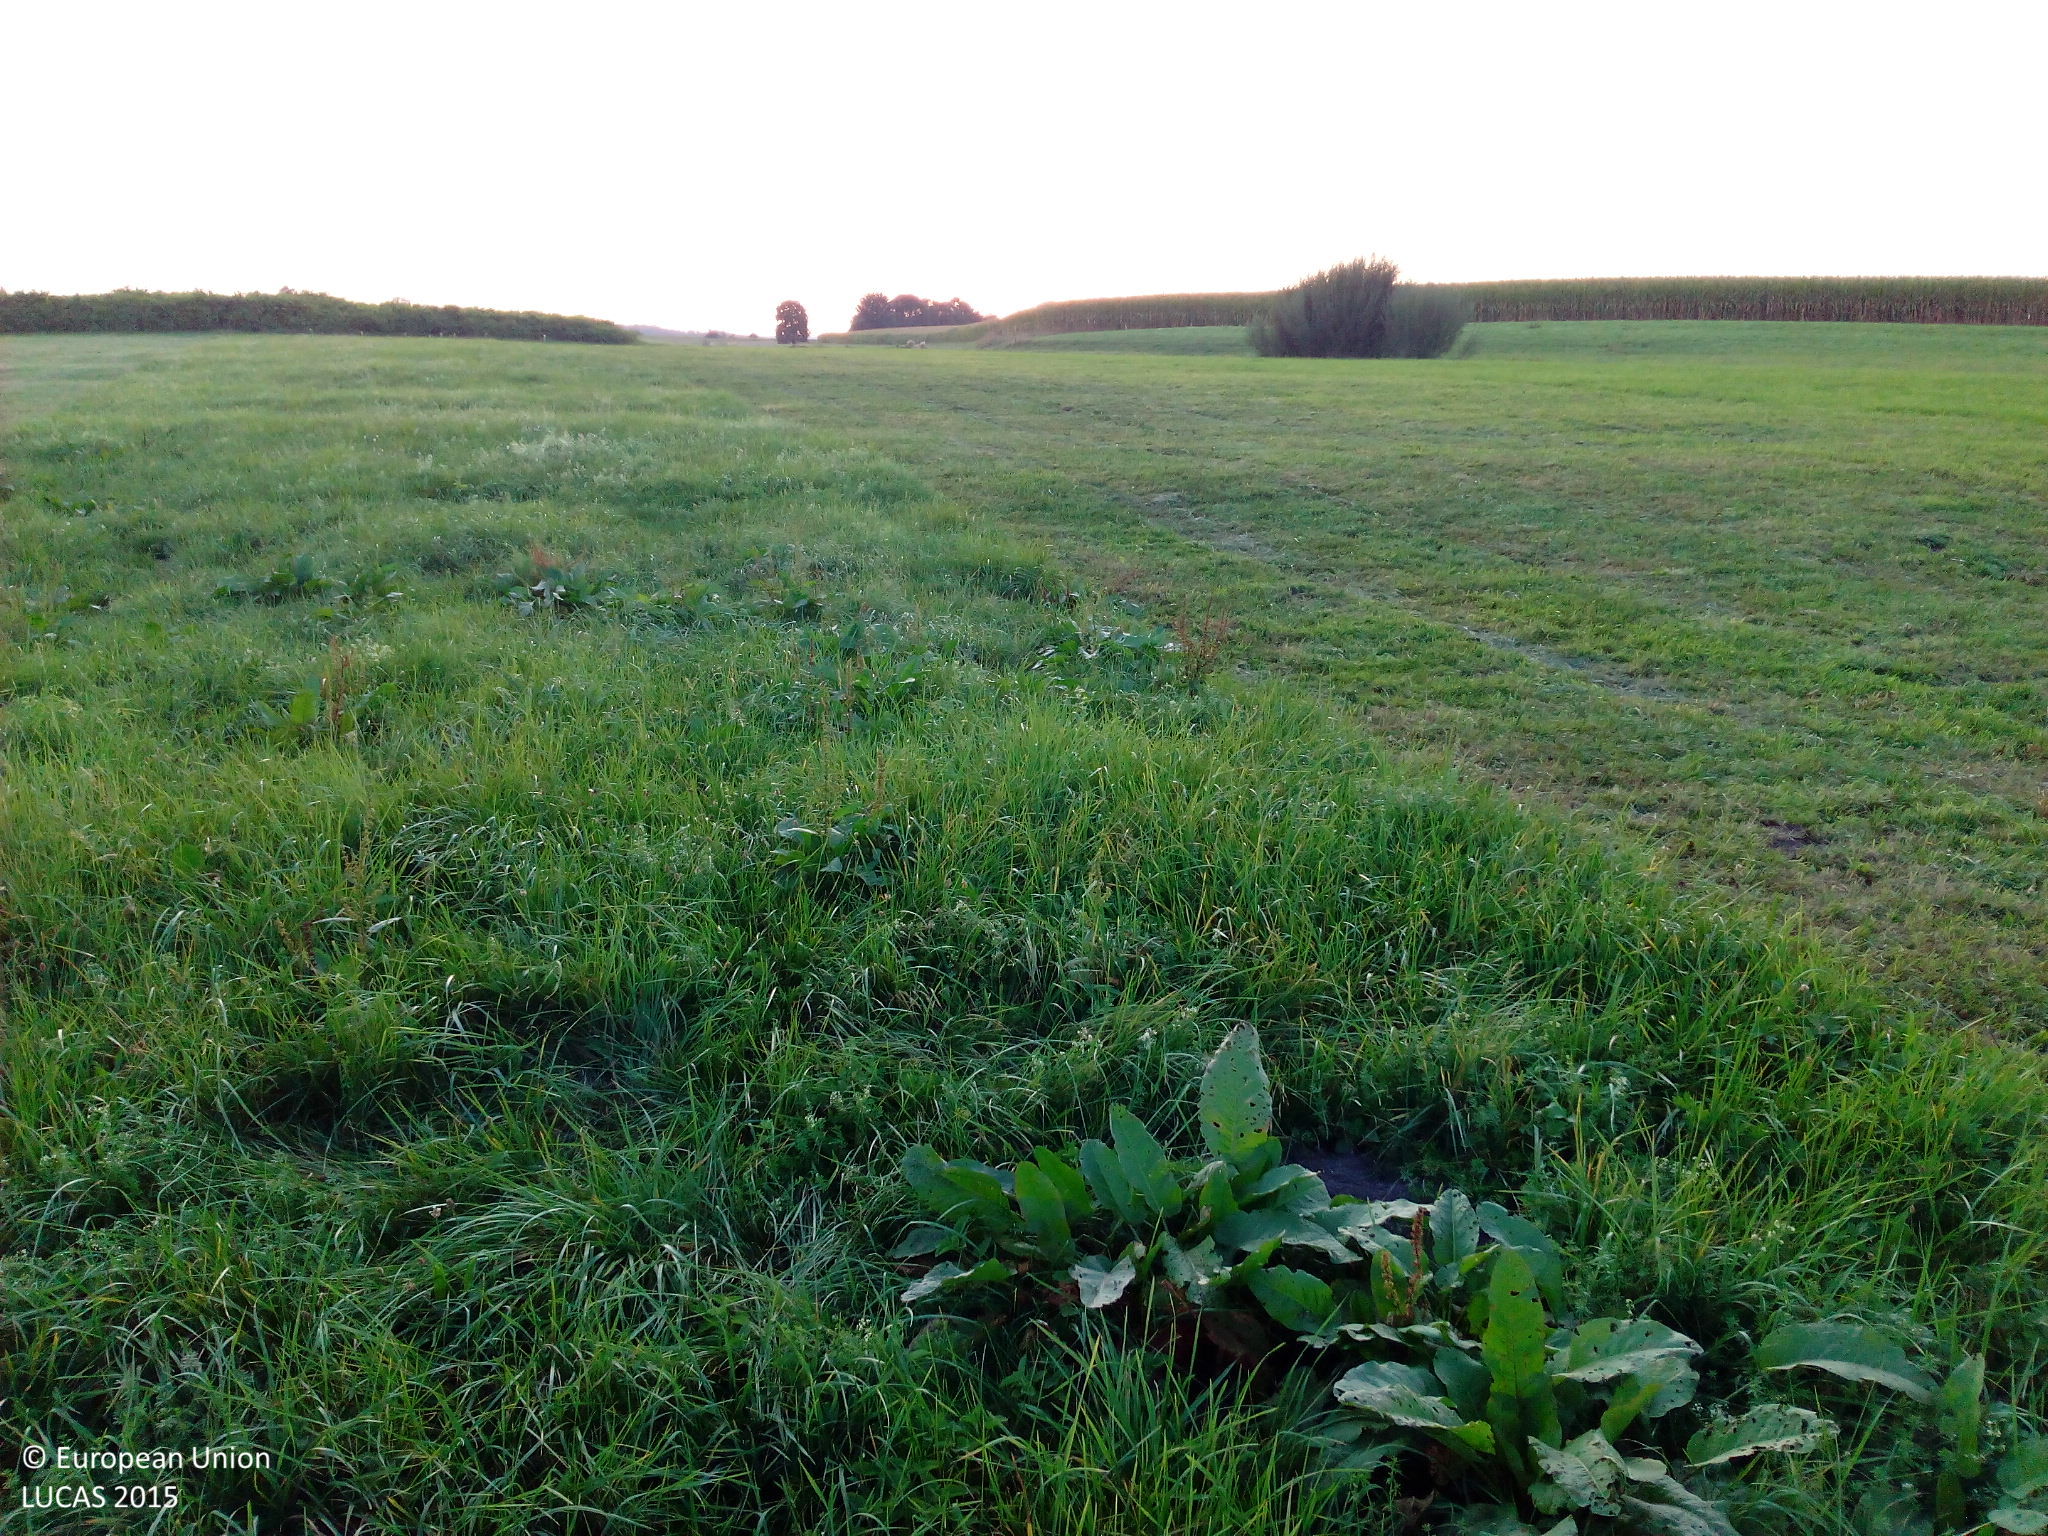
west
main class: Grassland
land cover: Grassland without tree/shrub cover
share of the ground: > 75 %
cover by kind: herbaceous plants 100 %
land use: Agriculture (excluding fallow land and kitchen gardens)
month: August
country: DE
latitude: 48.5290
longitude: 10.3113
